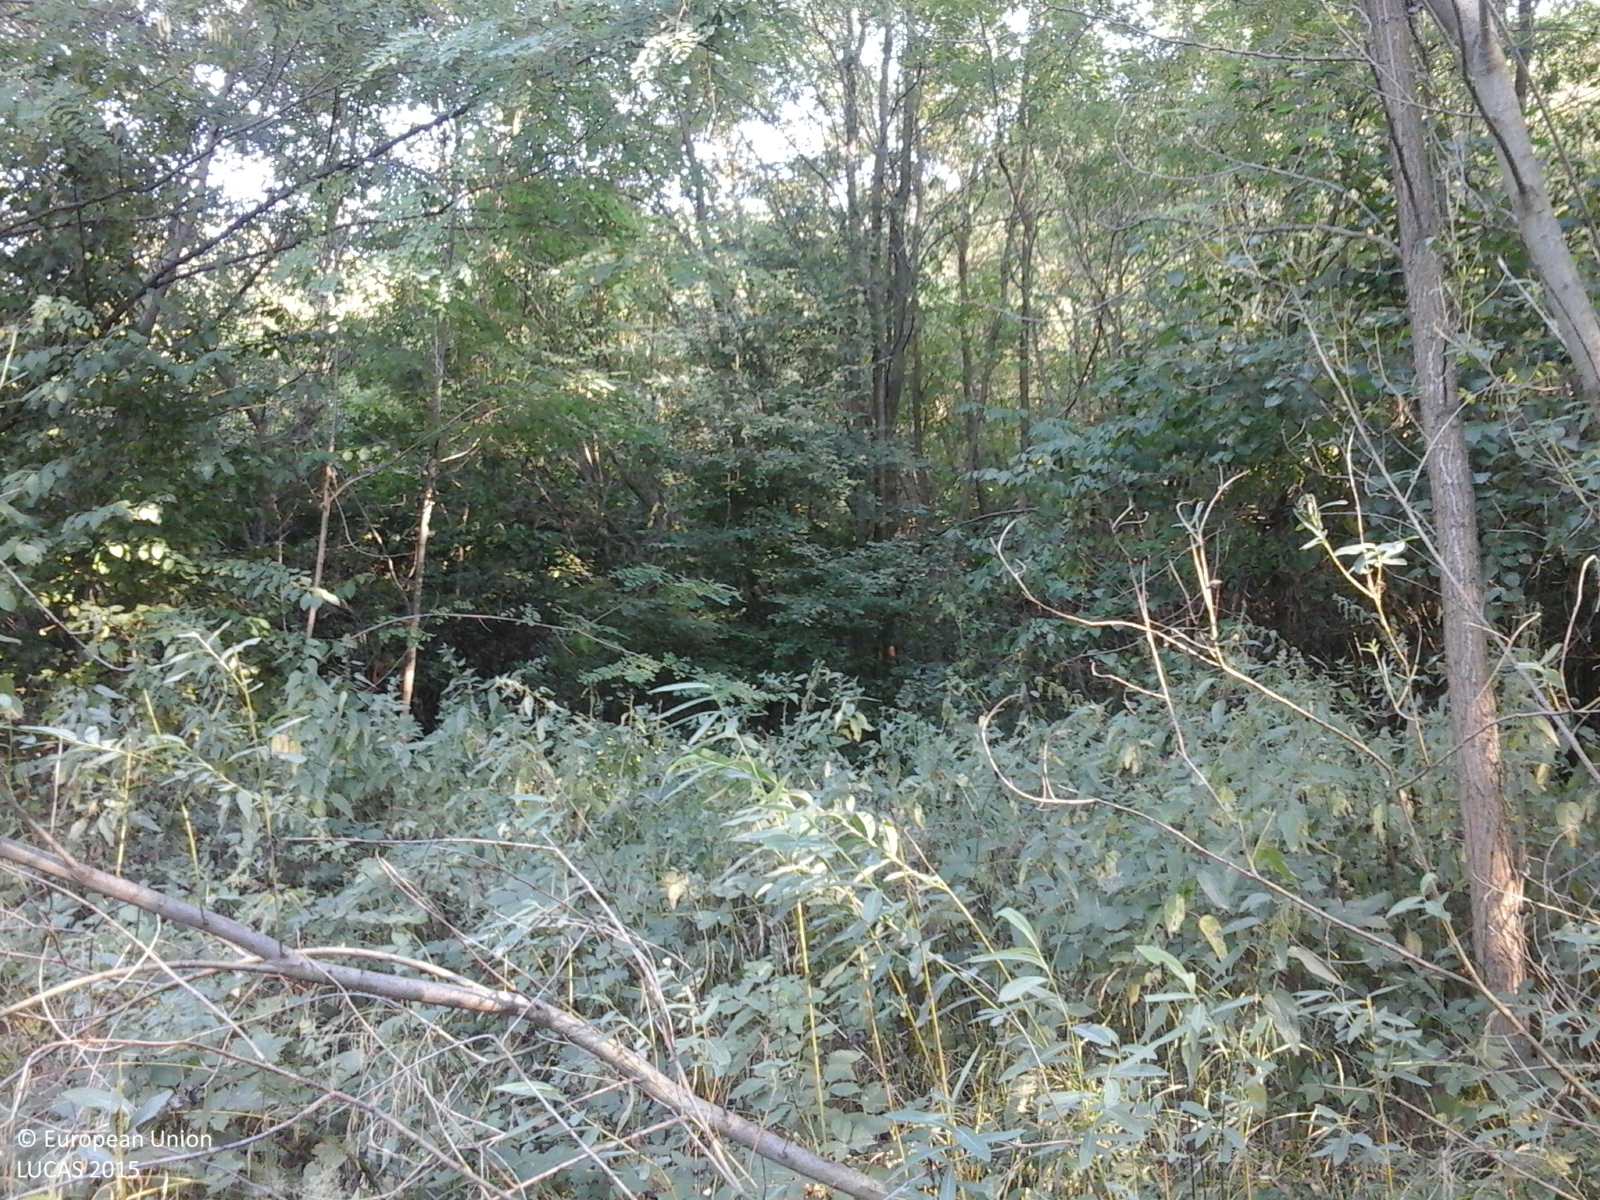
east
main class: Woodland
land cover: Broadleaved woodland
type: acidophilous oak and oak-birch forest
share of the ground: > 75 %
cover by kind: broadleaved forest trees 100 %
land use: Forestry
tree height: > 5 m
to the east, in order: Broadleaved woodland
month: August
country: RO
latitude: 44.4146
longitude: 23.6307
